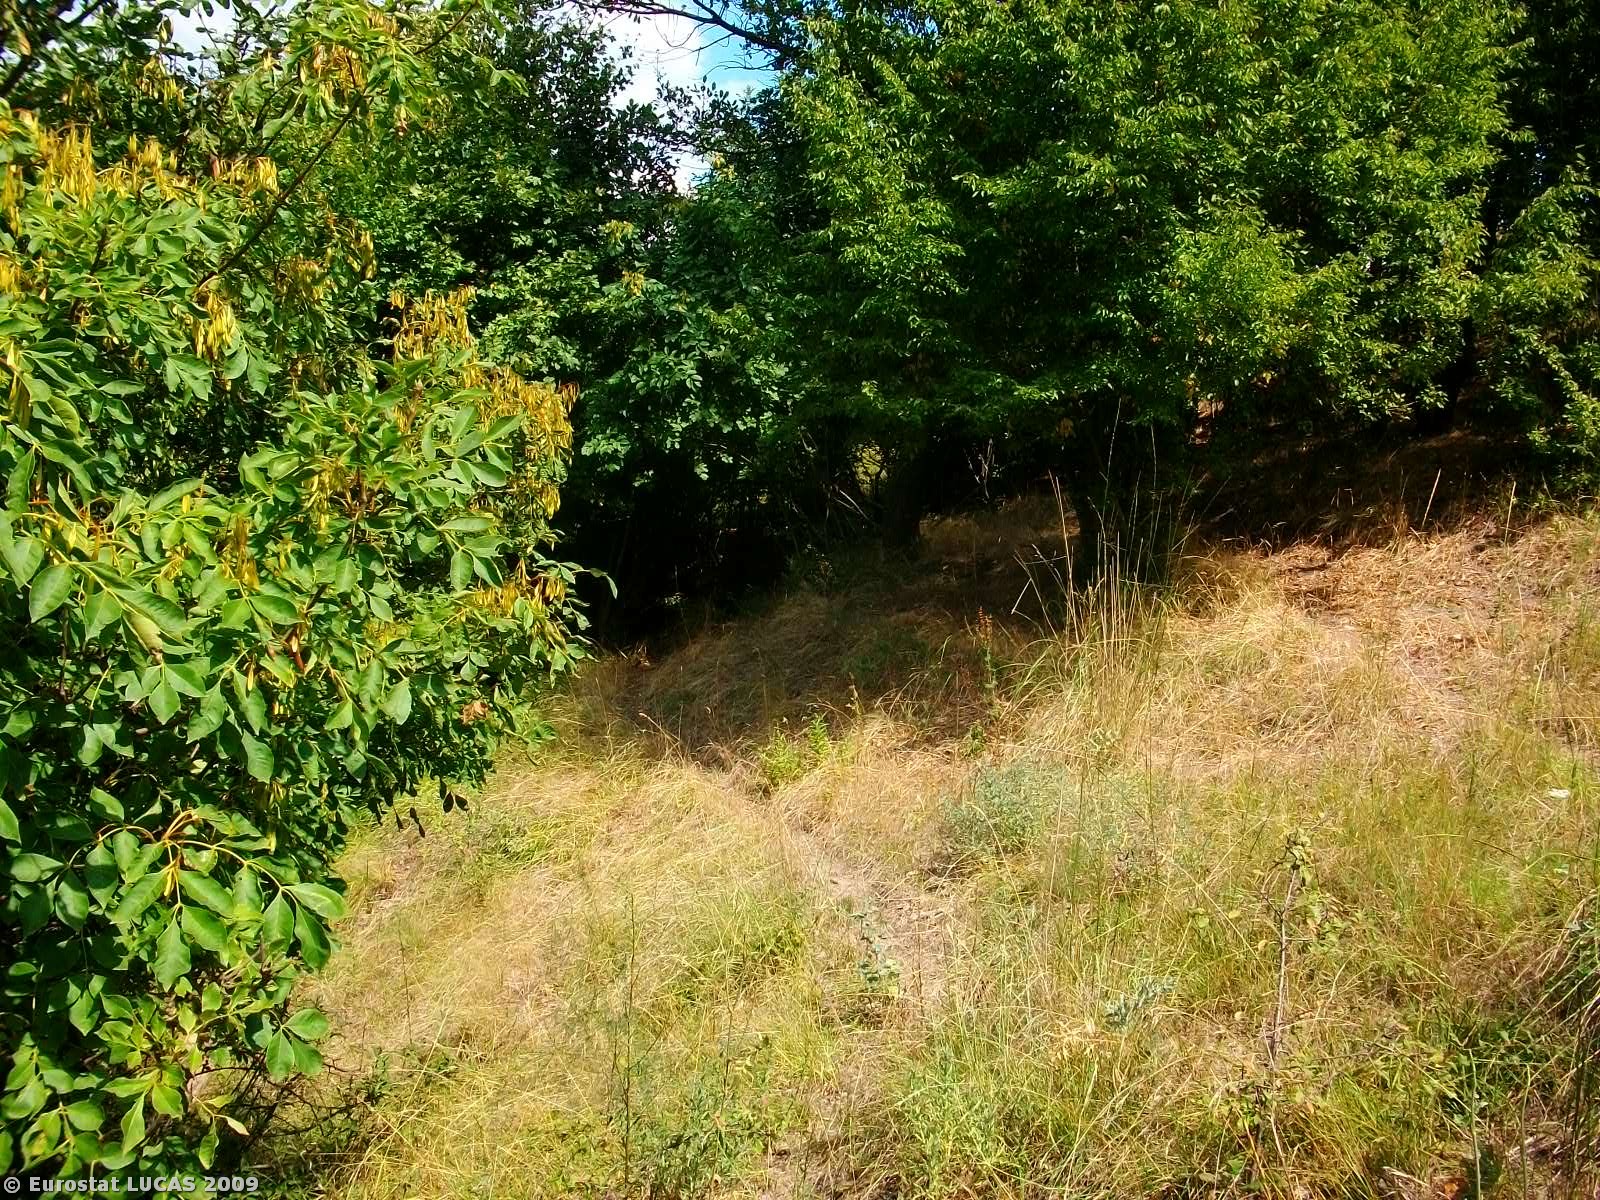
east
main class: Woodland
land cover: Broadleaved woodland
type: thermophilous deciduous forest
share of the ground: 50 - 75 %
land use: Forestry
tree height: > 5 m
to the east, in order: Broadleaved woodland; Grassland with sparse tree/shrub cover; Broadleaved woodland; Rivers and streams; Broadleaved woodland; Grassland without tree/shrub cover; Common wheat
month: August
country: GR
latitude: 41.4315
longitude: 26.5330
